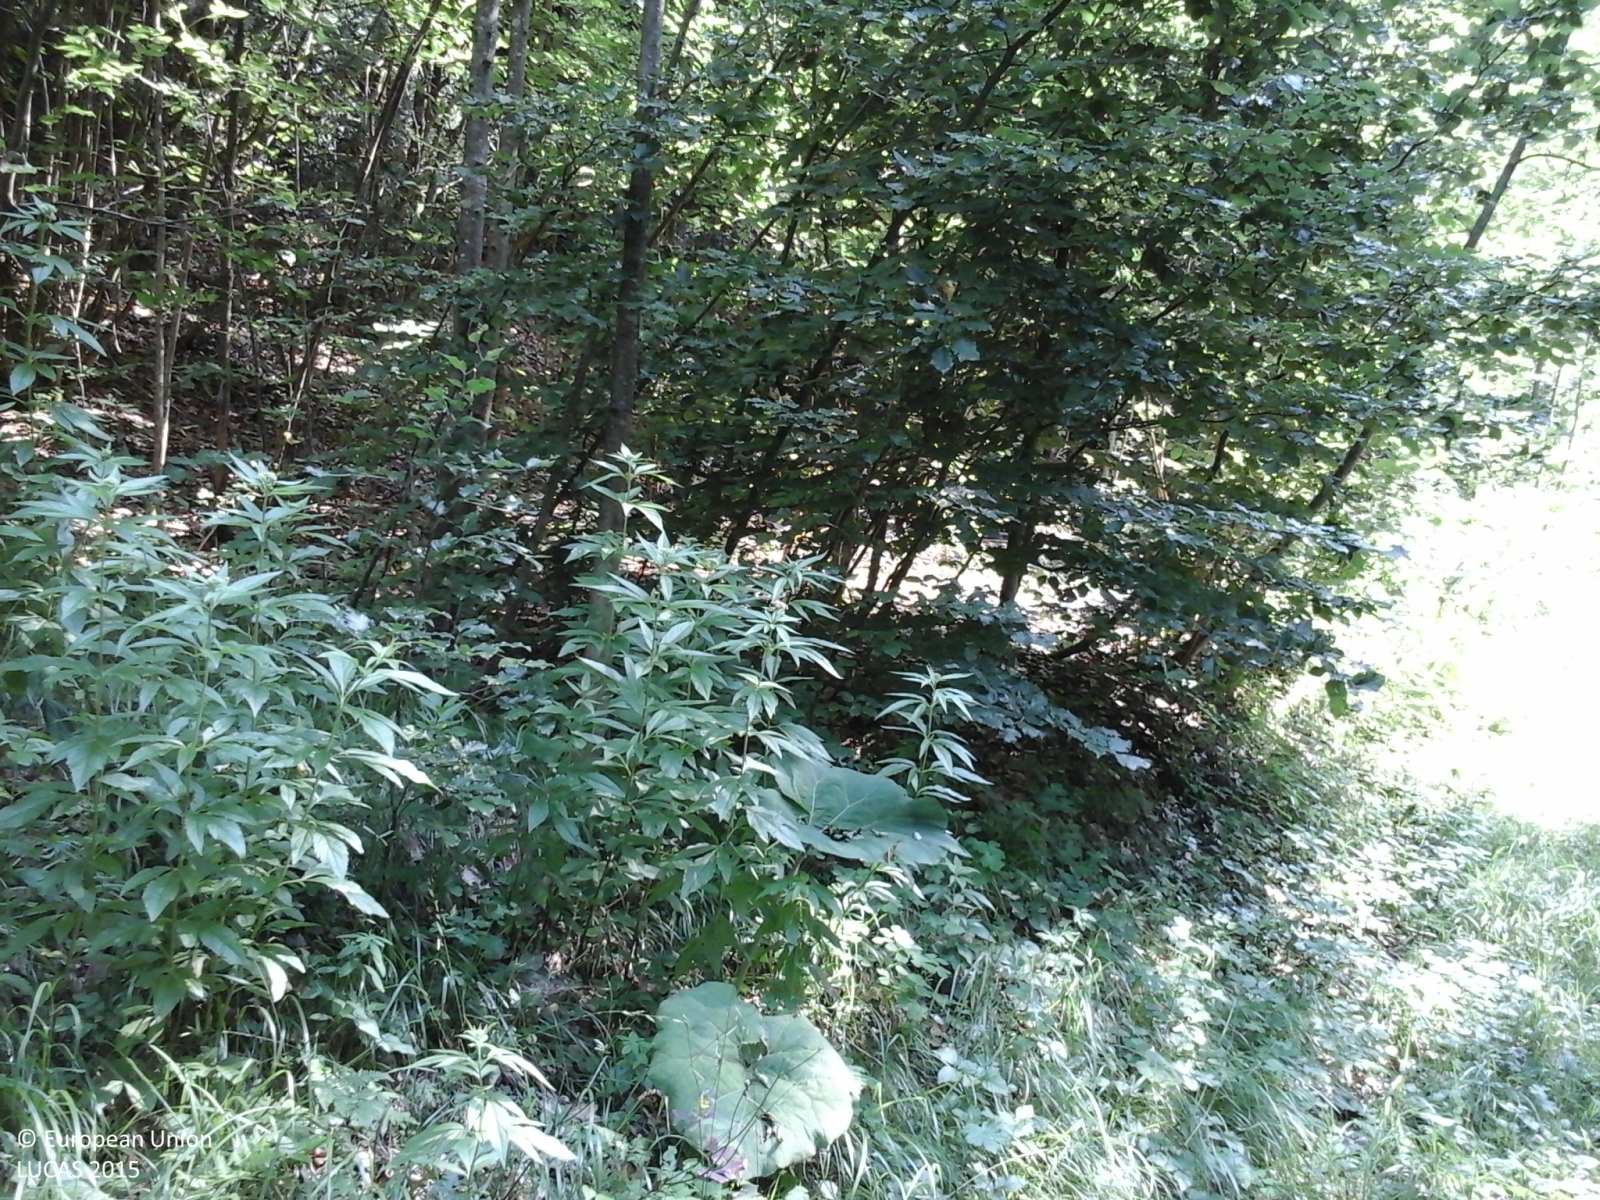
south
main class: Woodland
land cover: Other mixed woodland
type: mountainous beech forest
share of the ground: > 75 %
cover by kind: broadleaved forest trees 70 %, coniferous forest trees 30 %
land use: Semi-natural and natural areas not in use
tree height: > 5 m
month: July
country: IT
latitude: 44.4586
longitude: 7.2531
